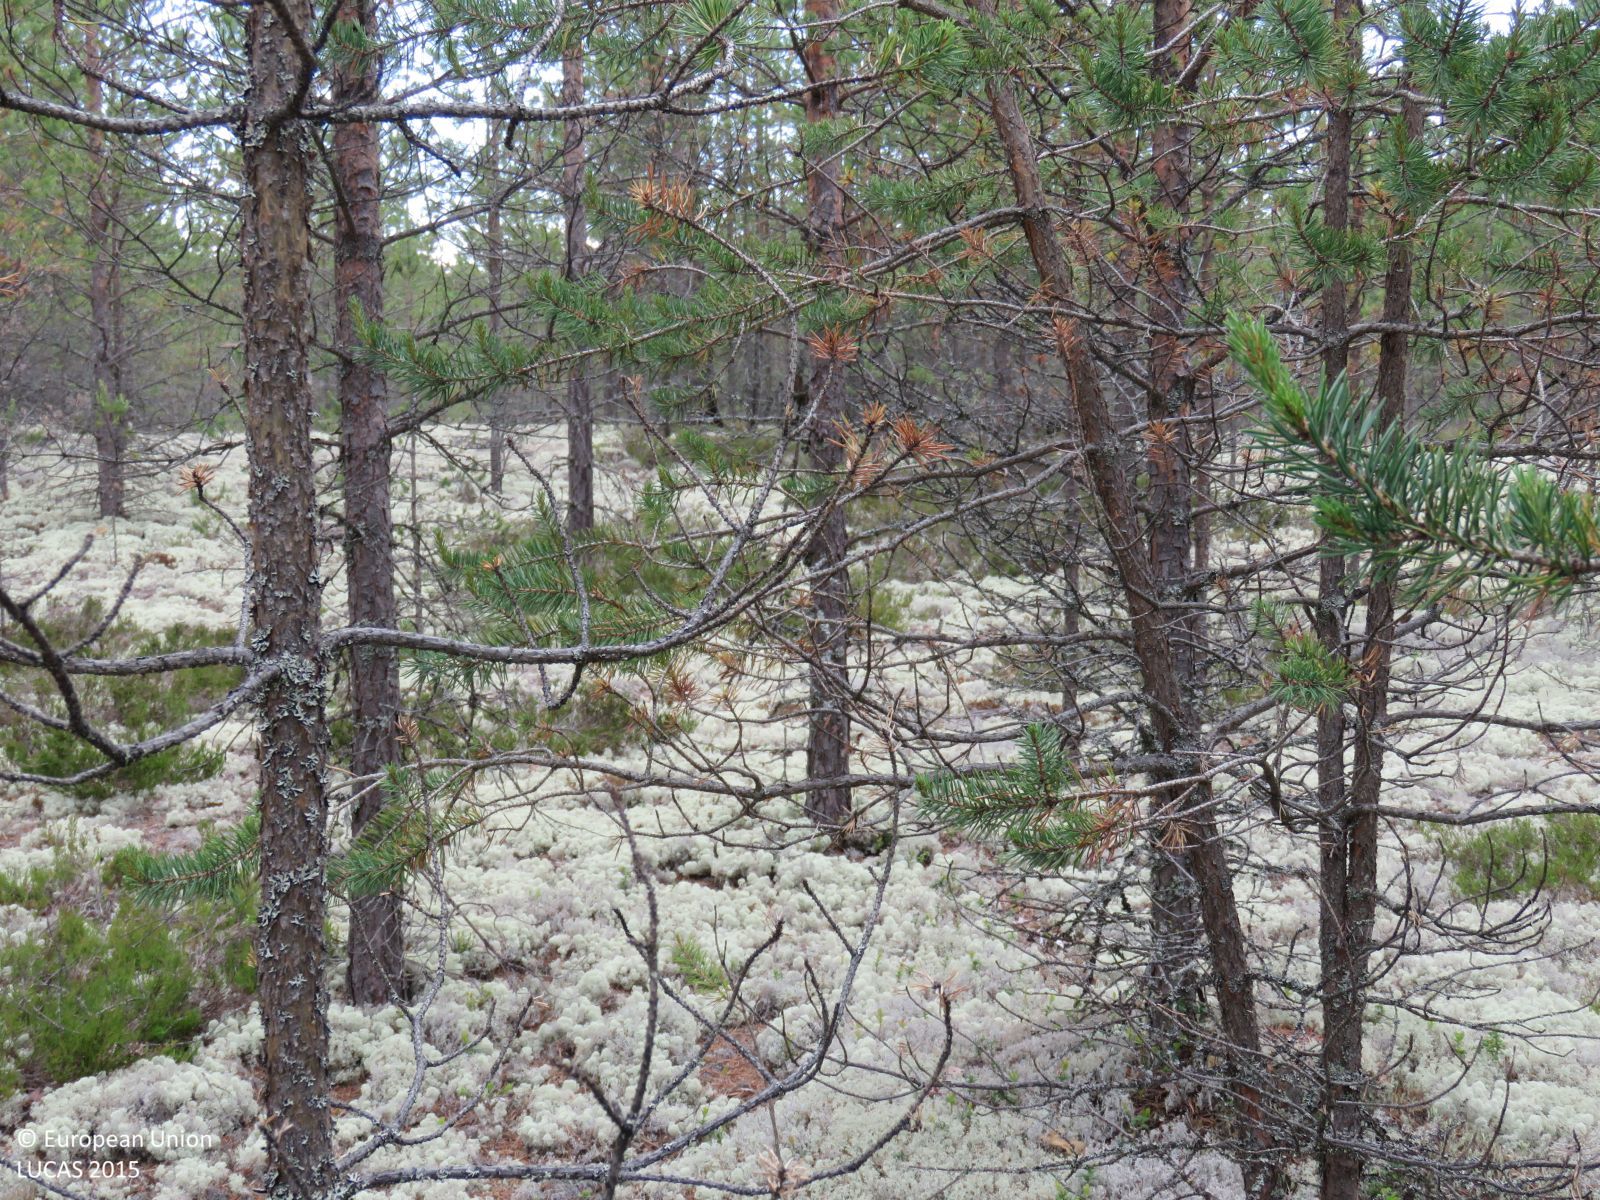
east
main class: Woodland
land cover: Pine dominated coniferous woodland
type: boreal forest
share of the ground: 50 - 75 %
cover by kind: coniferous forest trees 50 %, lichens and mosses 35 %, shrubs 10 %, unconsolidated bare surface 5 %
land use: Forestry
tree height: > 5 m
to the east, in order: Pine dominated coniferous woodland; Tracks; Pine dominated coniferous woodland; Tracks; Pine dominated coniferous woodland
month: July
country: FI
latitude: 64.4822
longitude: 26.7446
